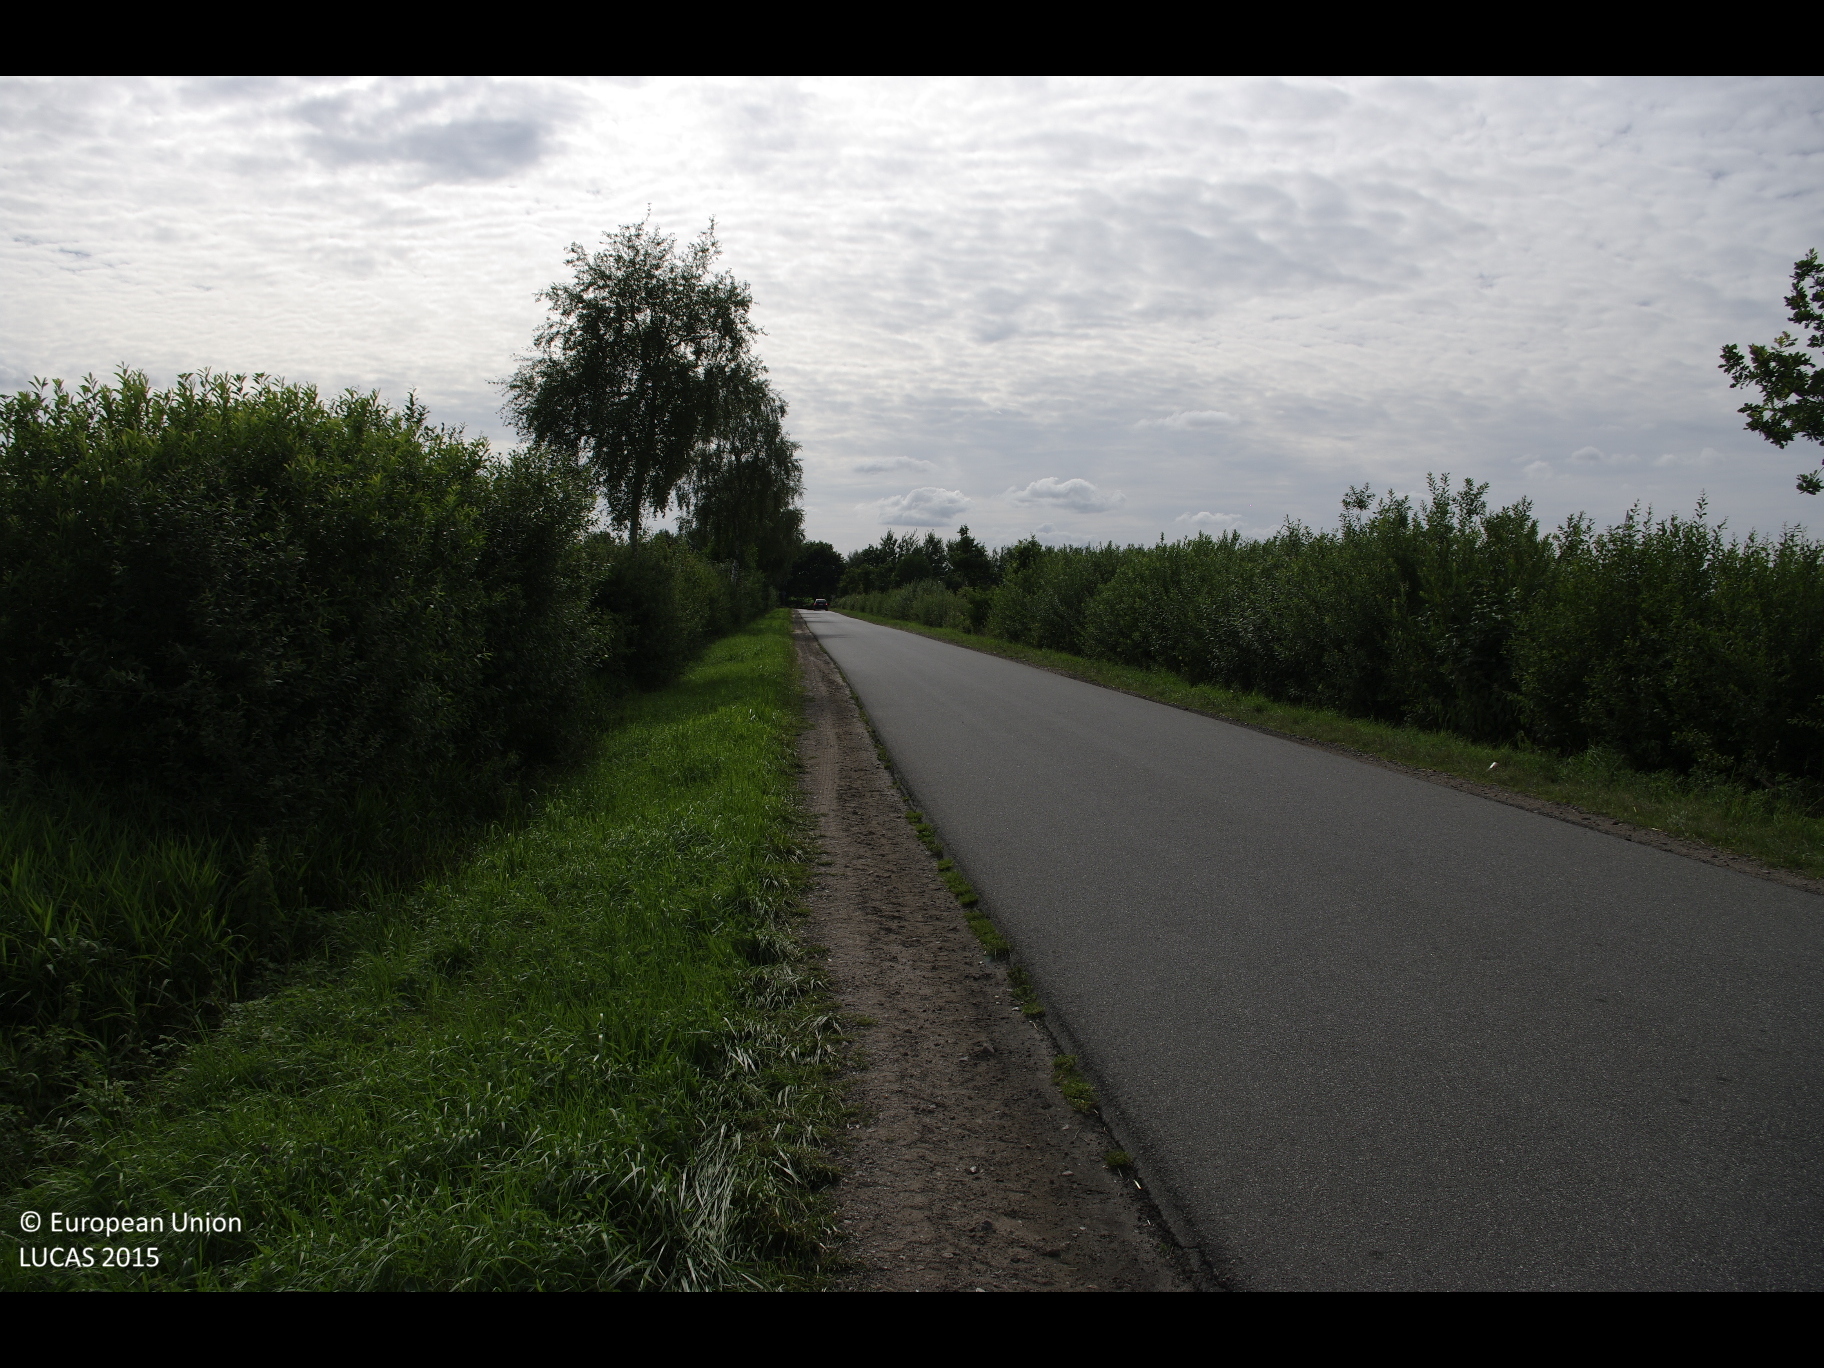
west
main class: Cropland
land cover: Maize
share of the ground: > 75 %
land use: Agriculture (excluding fallow land and kitchen gardens)
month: July
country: DE
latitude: 54.0309
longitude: 9.9237
